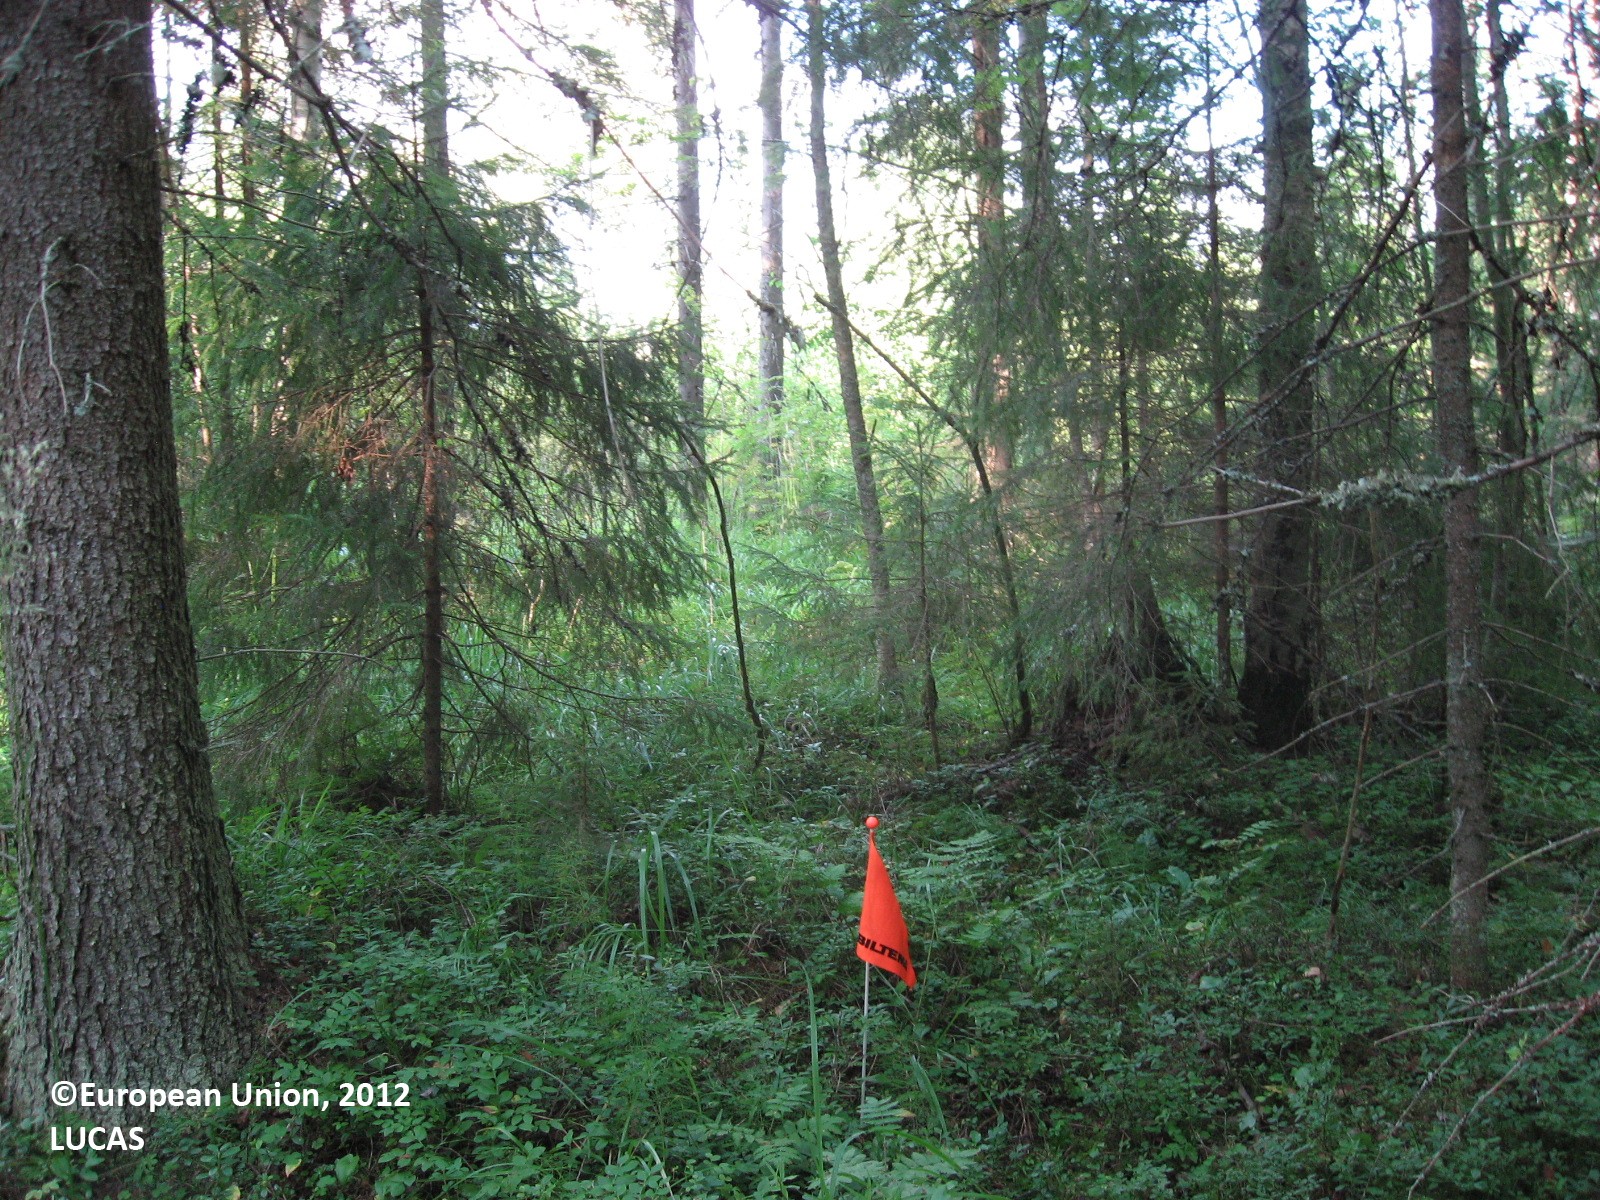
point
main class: Woodland
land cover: Spruce dominated mixed woodland
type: boreal forest
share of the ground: > 75 %
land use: Forestry
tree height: > 5 m
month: August
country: FI
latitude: 61.5176
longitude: 25.0544
